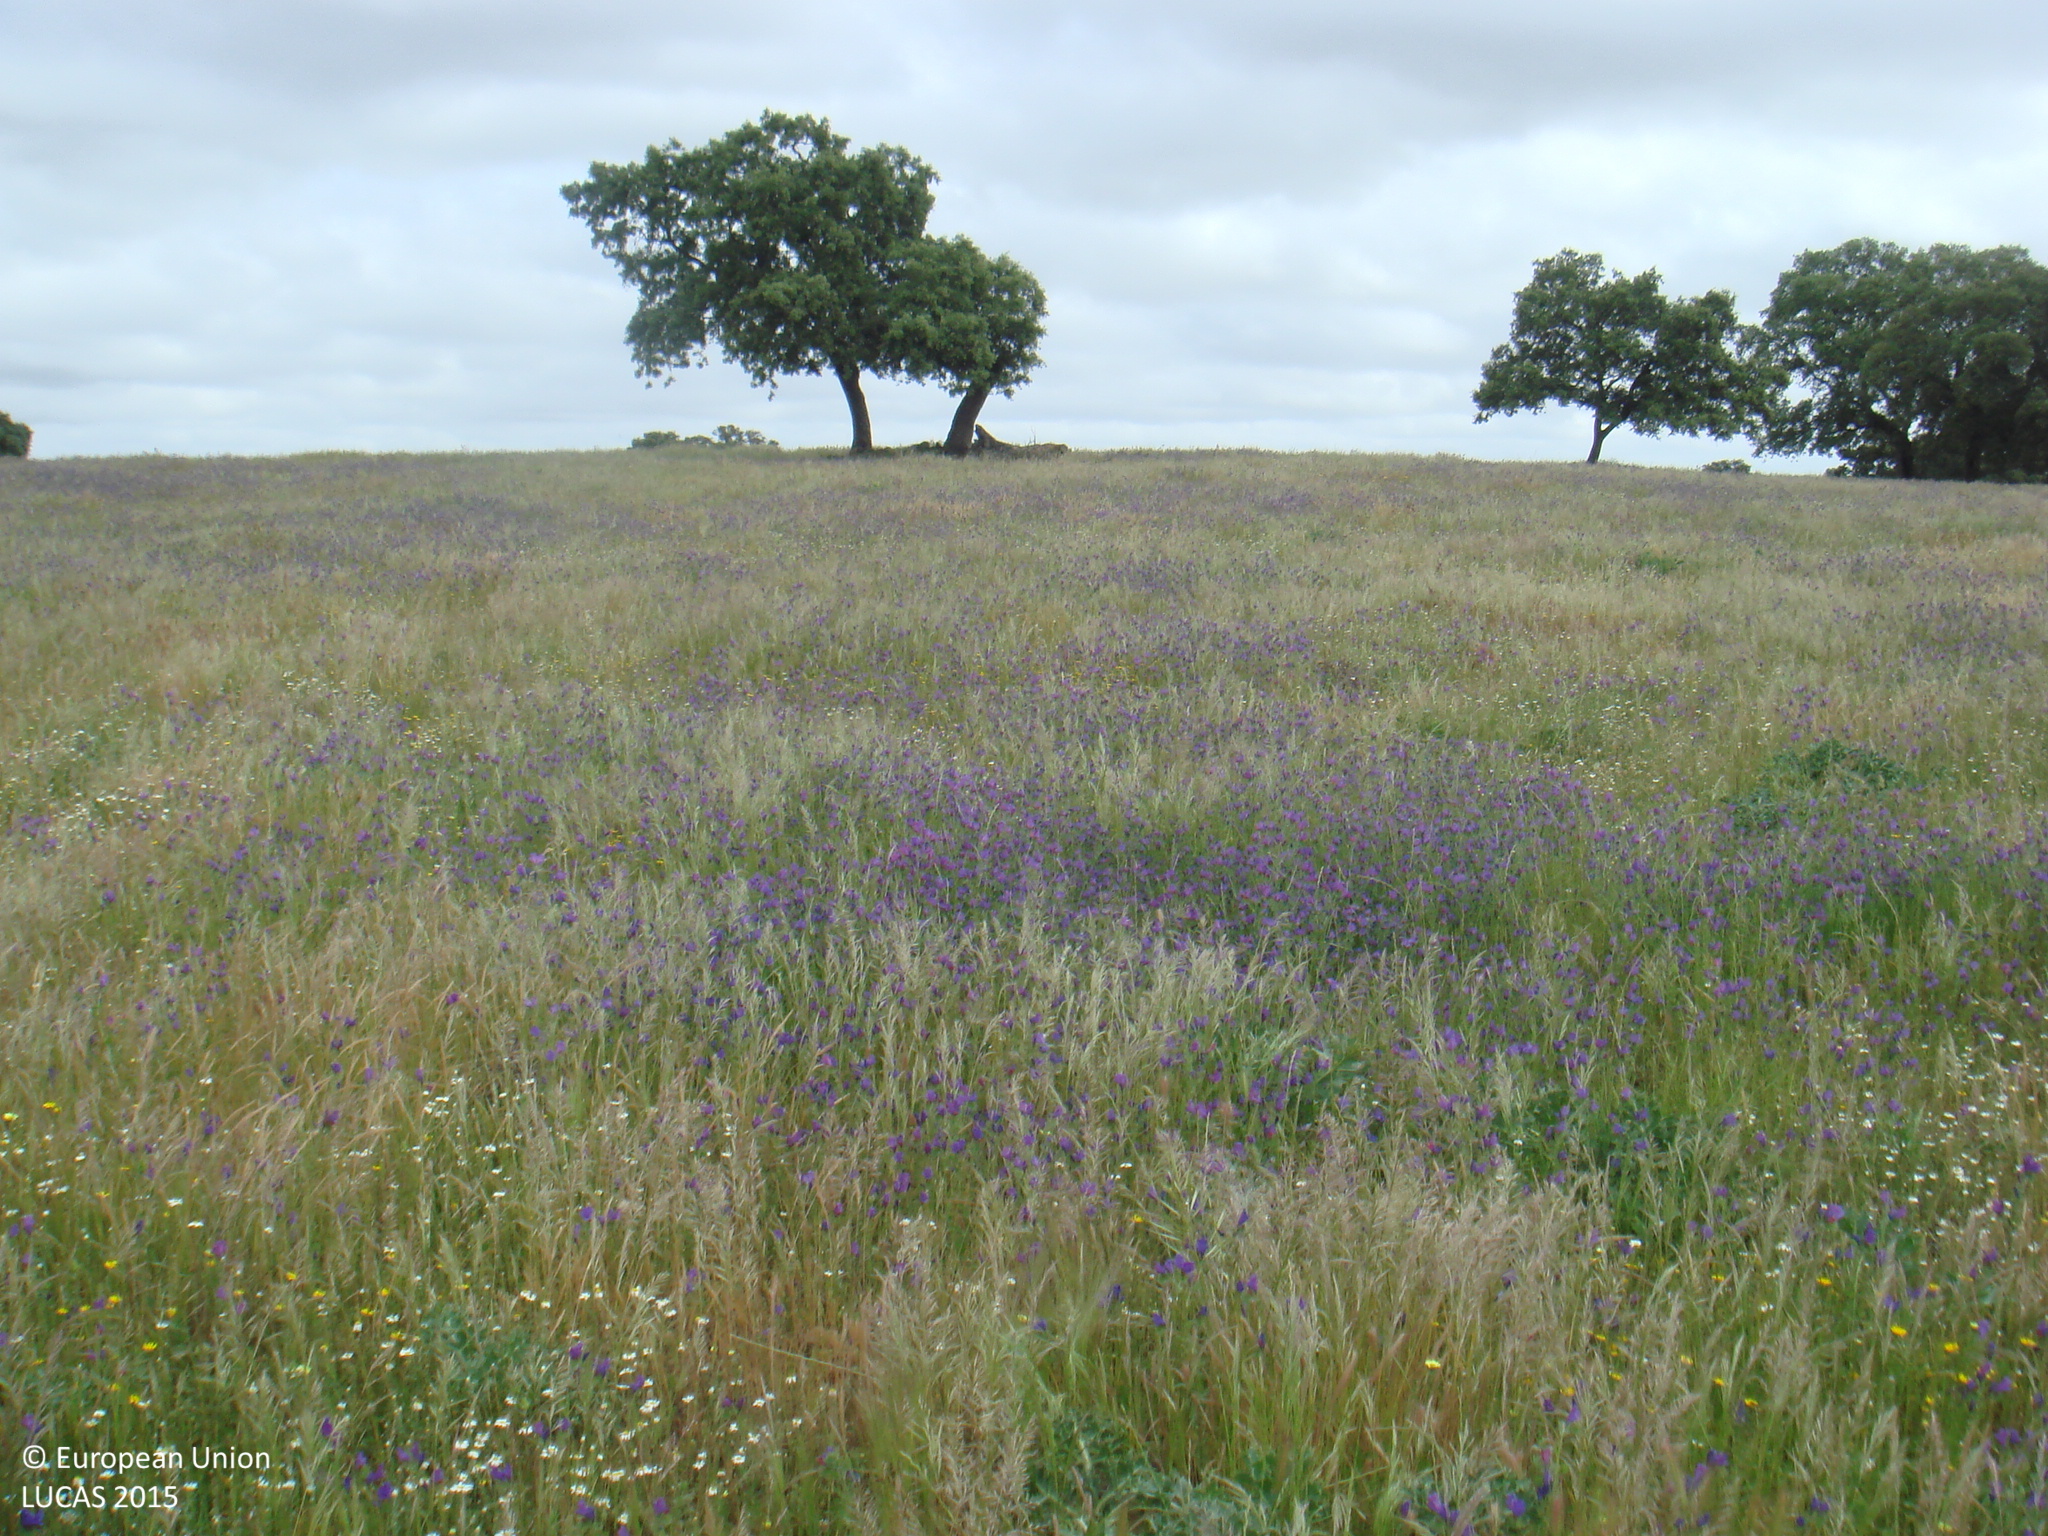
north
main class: Grassland
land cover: Grassland without tree/shrub cover
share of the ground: > 75 %
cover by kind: herbaceous plants 100 %
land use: Agriculture (excluding fallow land and kitchen gardens)
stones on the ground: < 10 %
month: May
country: ES
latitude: 38.4091
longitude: -4.7614
